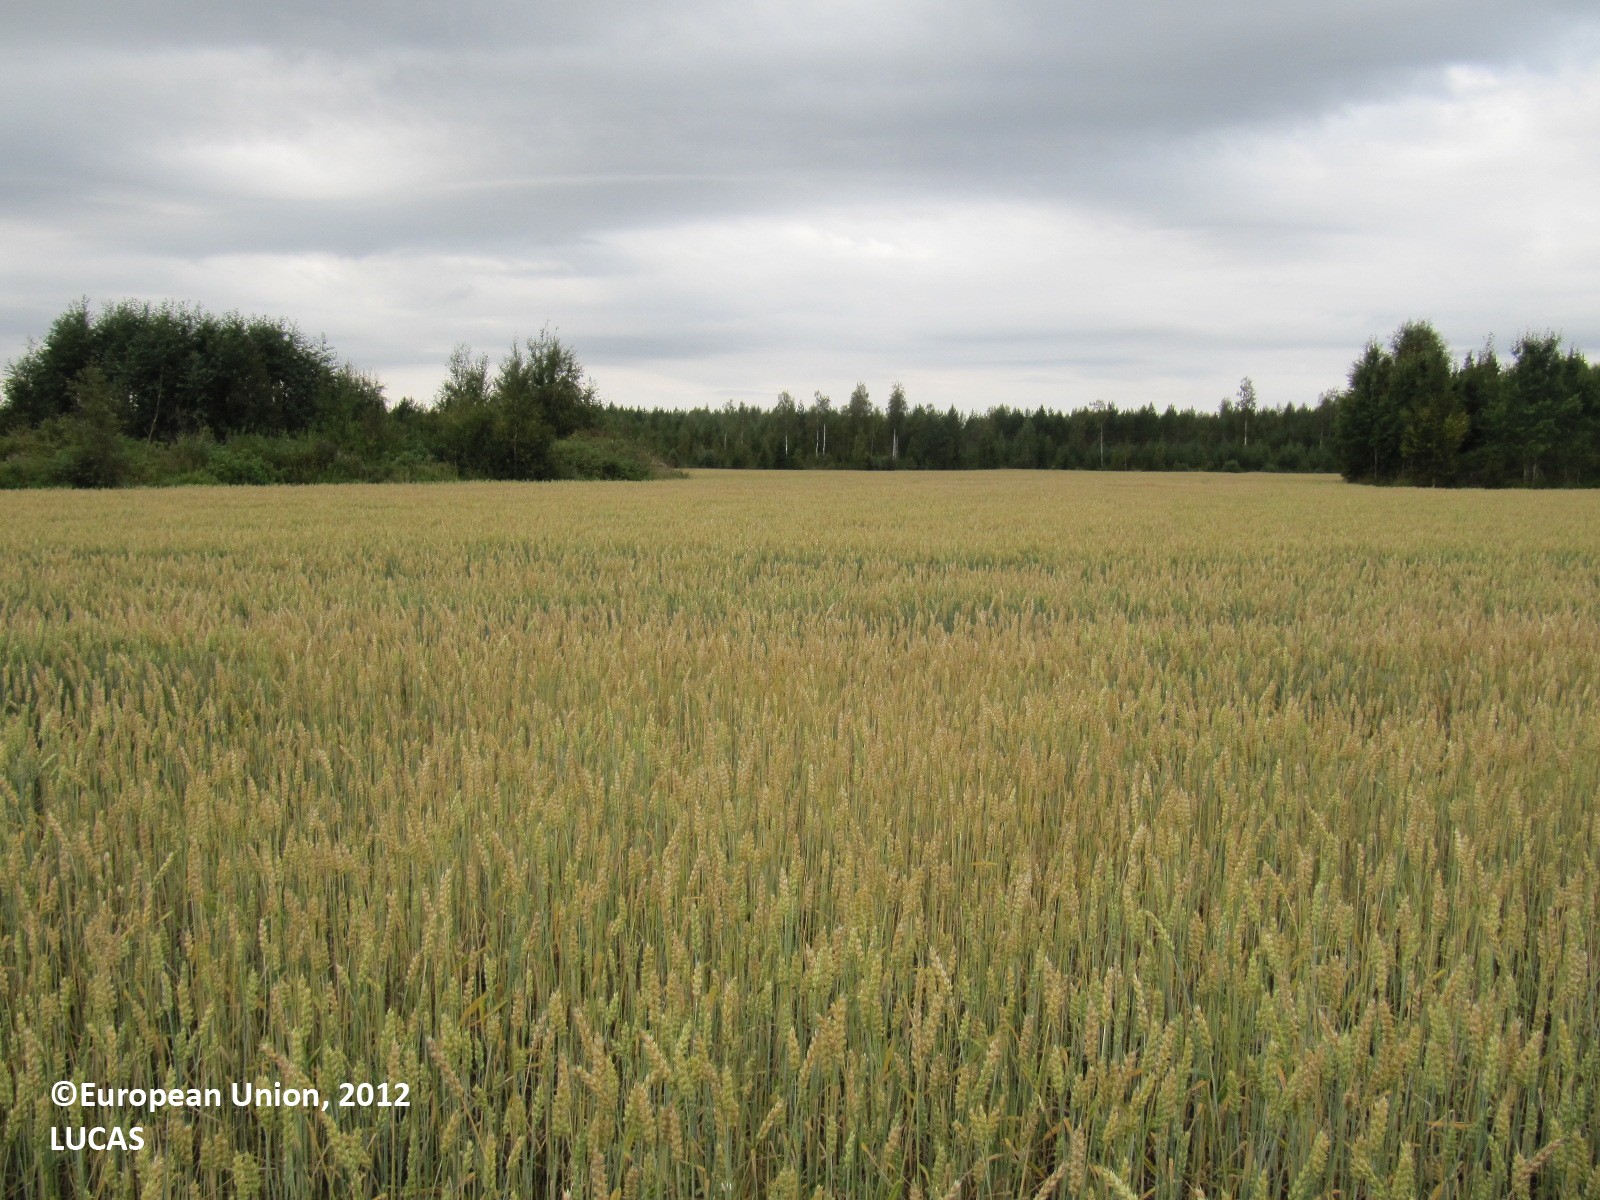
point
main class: Cropland
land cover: Common wheat
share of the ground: > 75 %
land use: Agriculture (excluding fallow land and kitchen gardens)
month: August
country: FI
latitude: 61.0970
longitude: 22.9638
